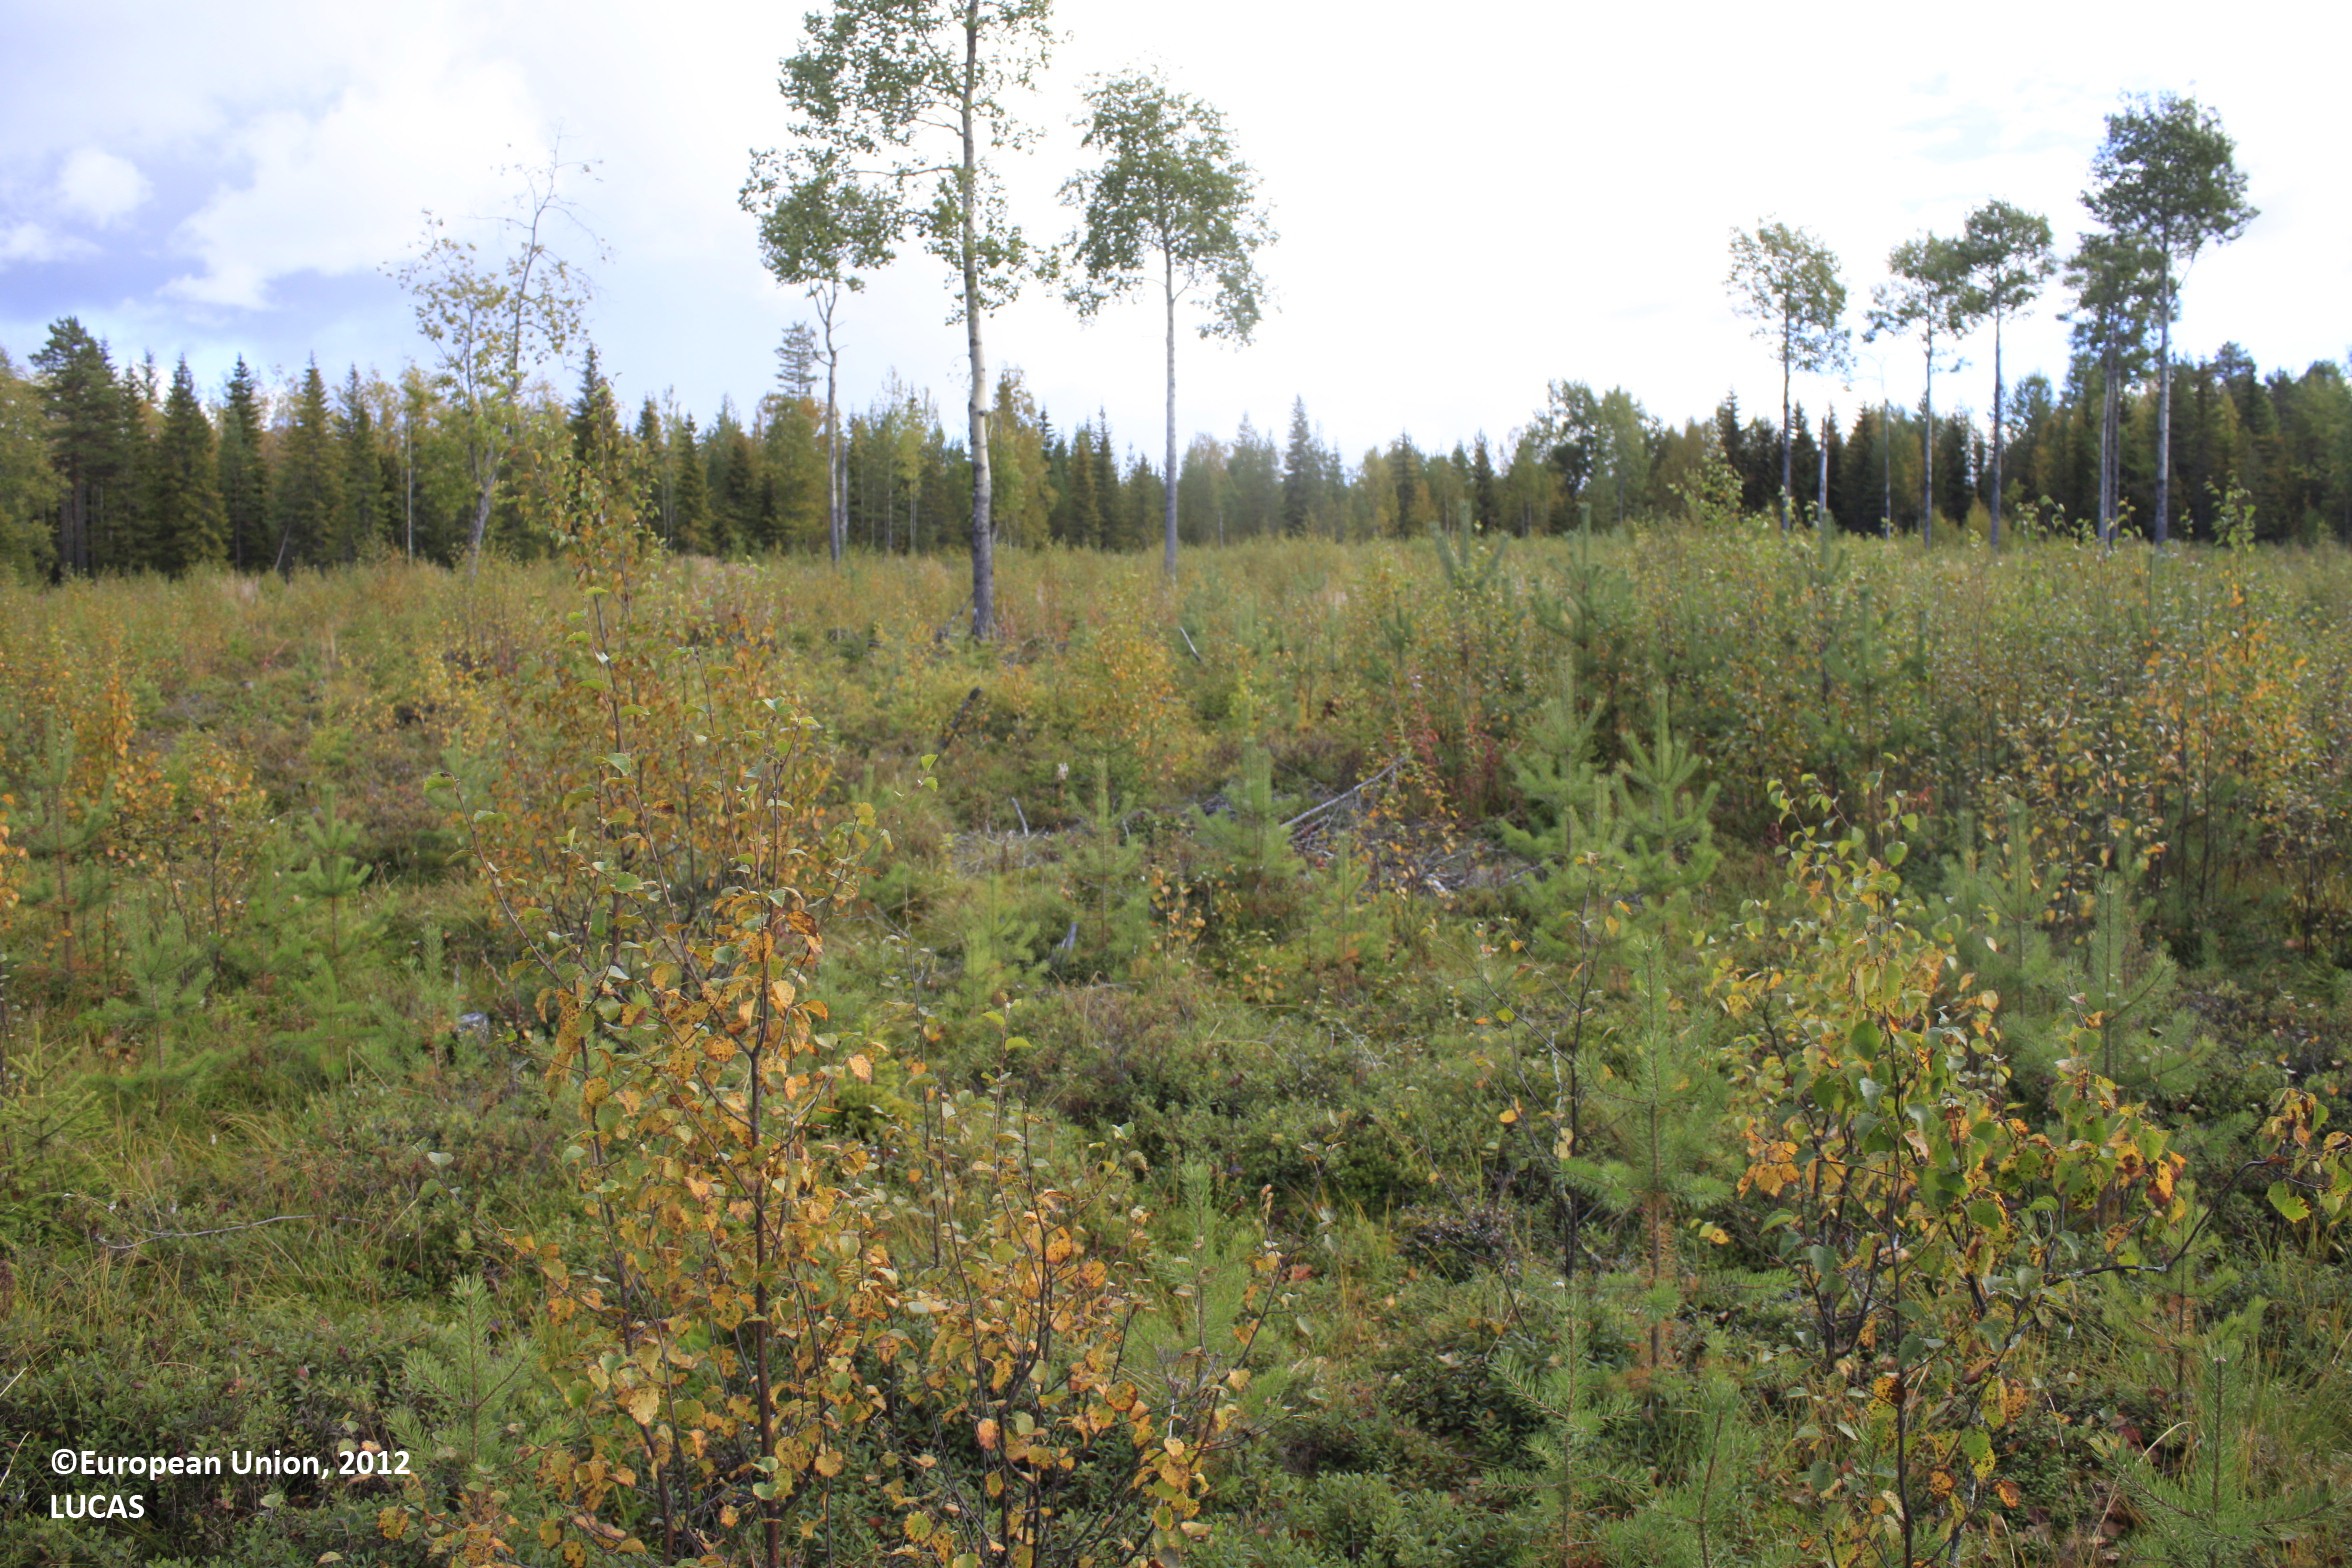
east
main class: Woodland
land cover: Broadleaved woodland
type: boreal forest
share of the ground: 25 - 50 %
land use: Forestry
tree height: < 5 m
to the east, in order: Broadleaved woodland; Ditches and canals; Broadleaved woodland; Ditches and canals; Broadleaved woodland; Ditches and canals; Broadleaved woodland; Ditches and canals; Pine dominated mixed woodland; Fences; Pine dominated mixed woodland
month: September
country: FI
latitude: 65.6496
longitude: 26.5992
